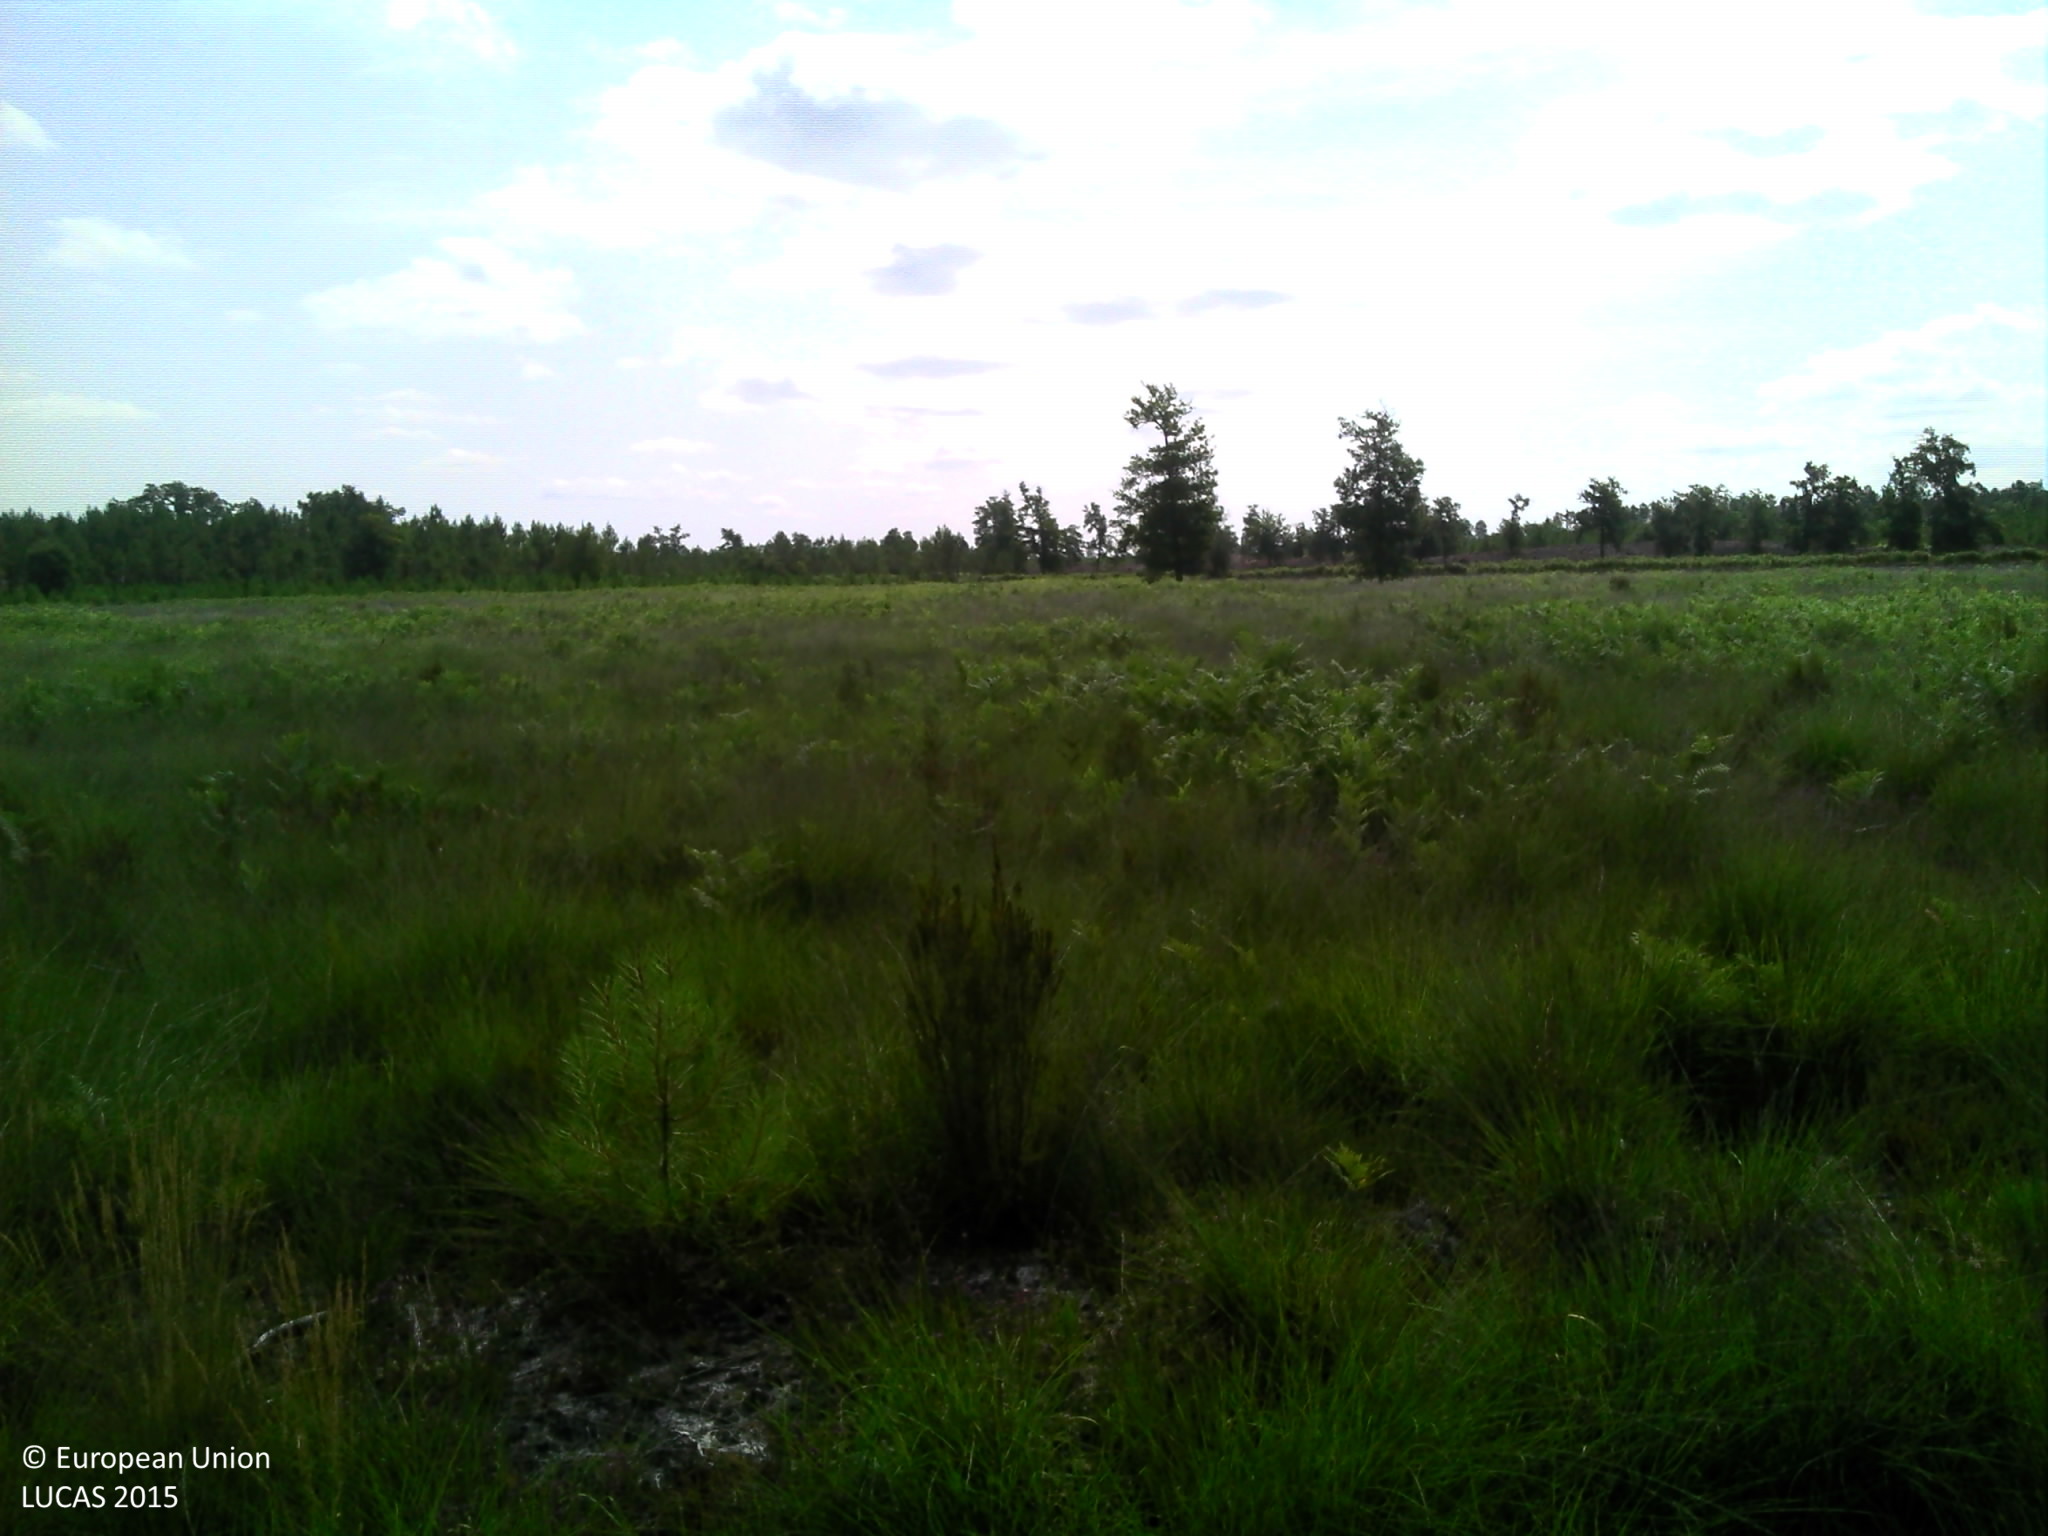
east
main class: Woodland
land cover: Pine dominated coniferous woodland
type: coniferous forest of the mediterranean region
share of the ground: 50 - 75 %
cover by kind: coniferous forest trees 60 %, herbaceous plants 40 %
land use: Forestry
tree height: < 5 m
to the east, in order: Pine dominated coniferous woodland; Spontaneously vegetated surfaces; Pine dominated coniferous woodland; Tracks
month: July
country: FR
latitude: 44.1842
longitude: -0.6357
